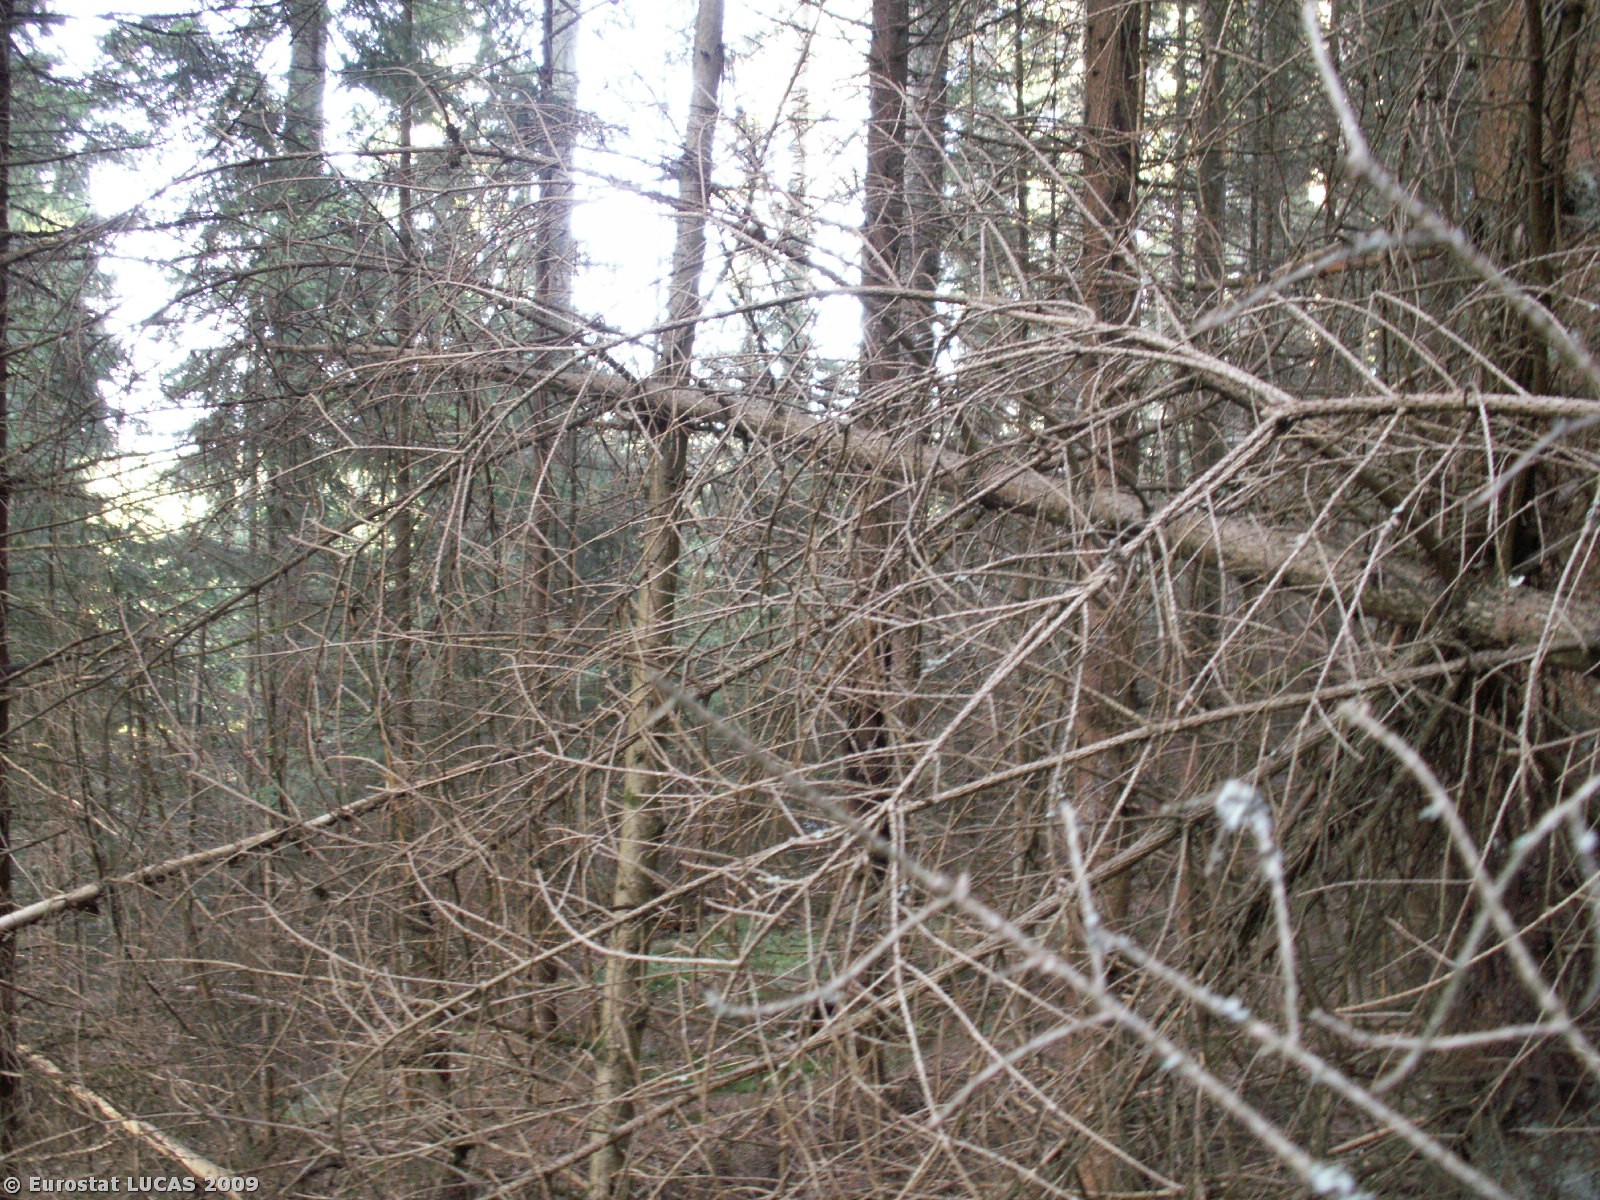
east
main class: Woodland
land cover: Coniferous woodland
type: hemiboreal forest and nemoral coniferous forest and mixed broadleaved-coniferous forest
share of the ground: > 75 %
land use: Forestry
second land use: Nature reserves
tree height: > 5 m
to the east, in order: Coniferous woodland; Ditches and canals; Paved roads, cycling and walking lanes; Grass margins; Coniferous woodland
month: July
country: CZ
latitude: 48.8415
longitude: 13.8289
